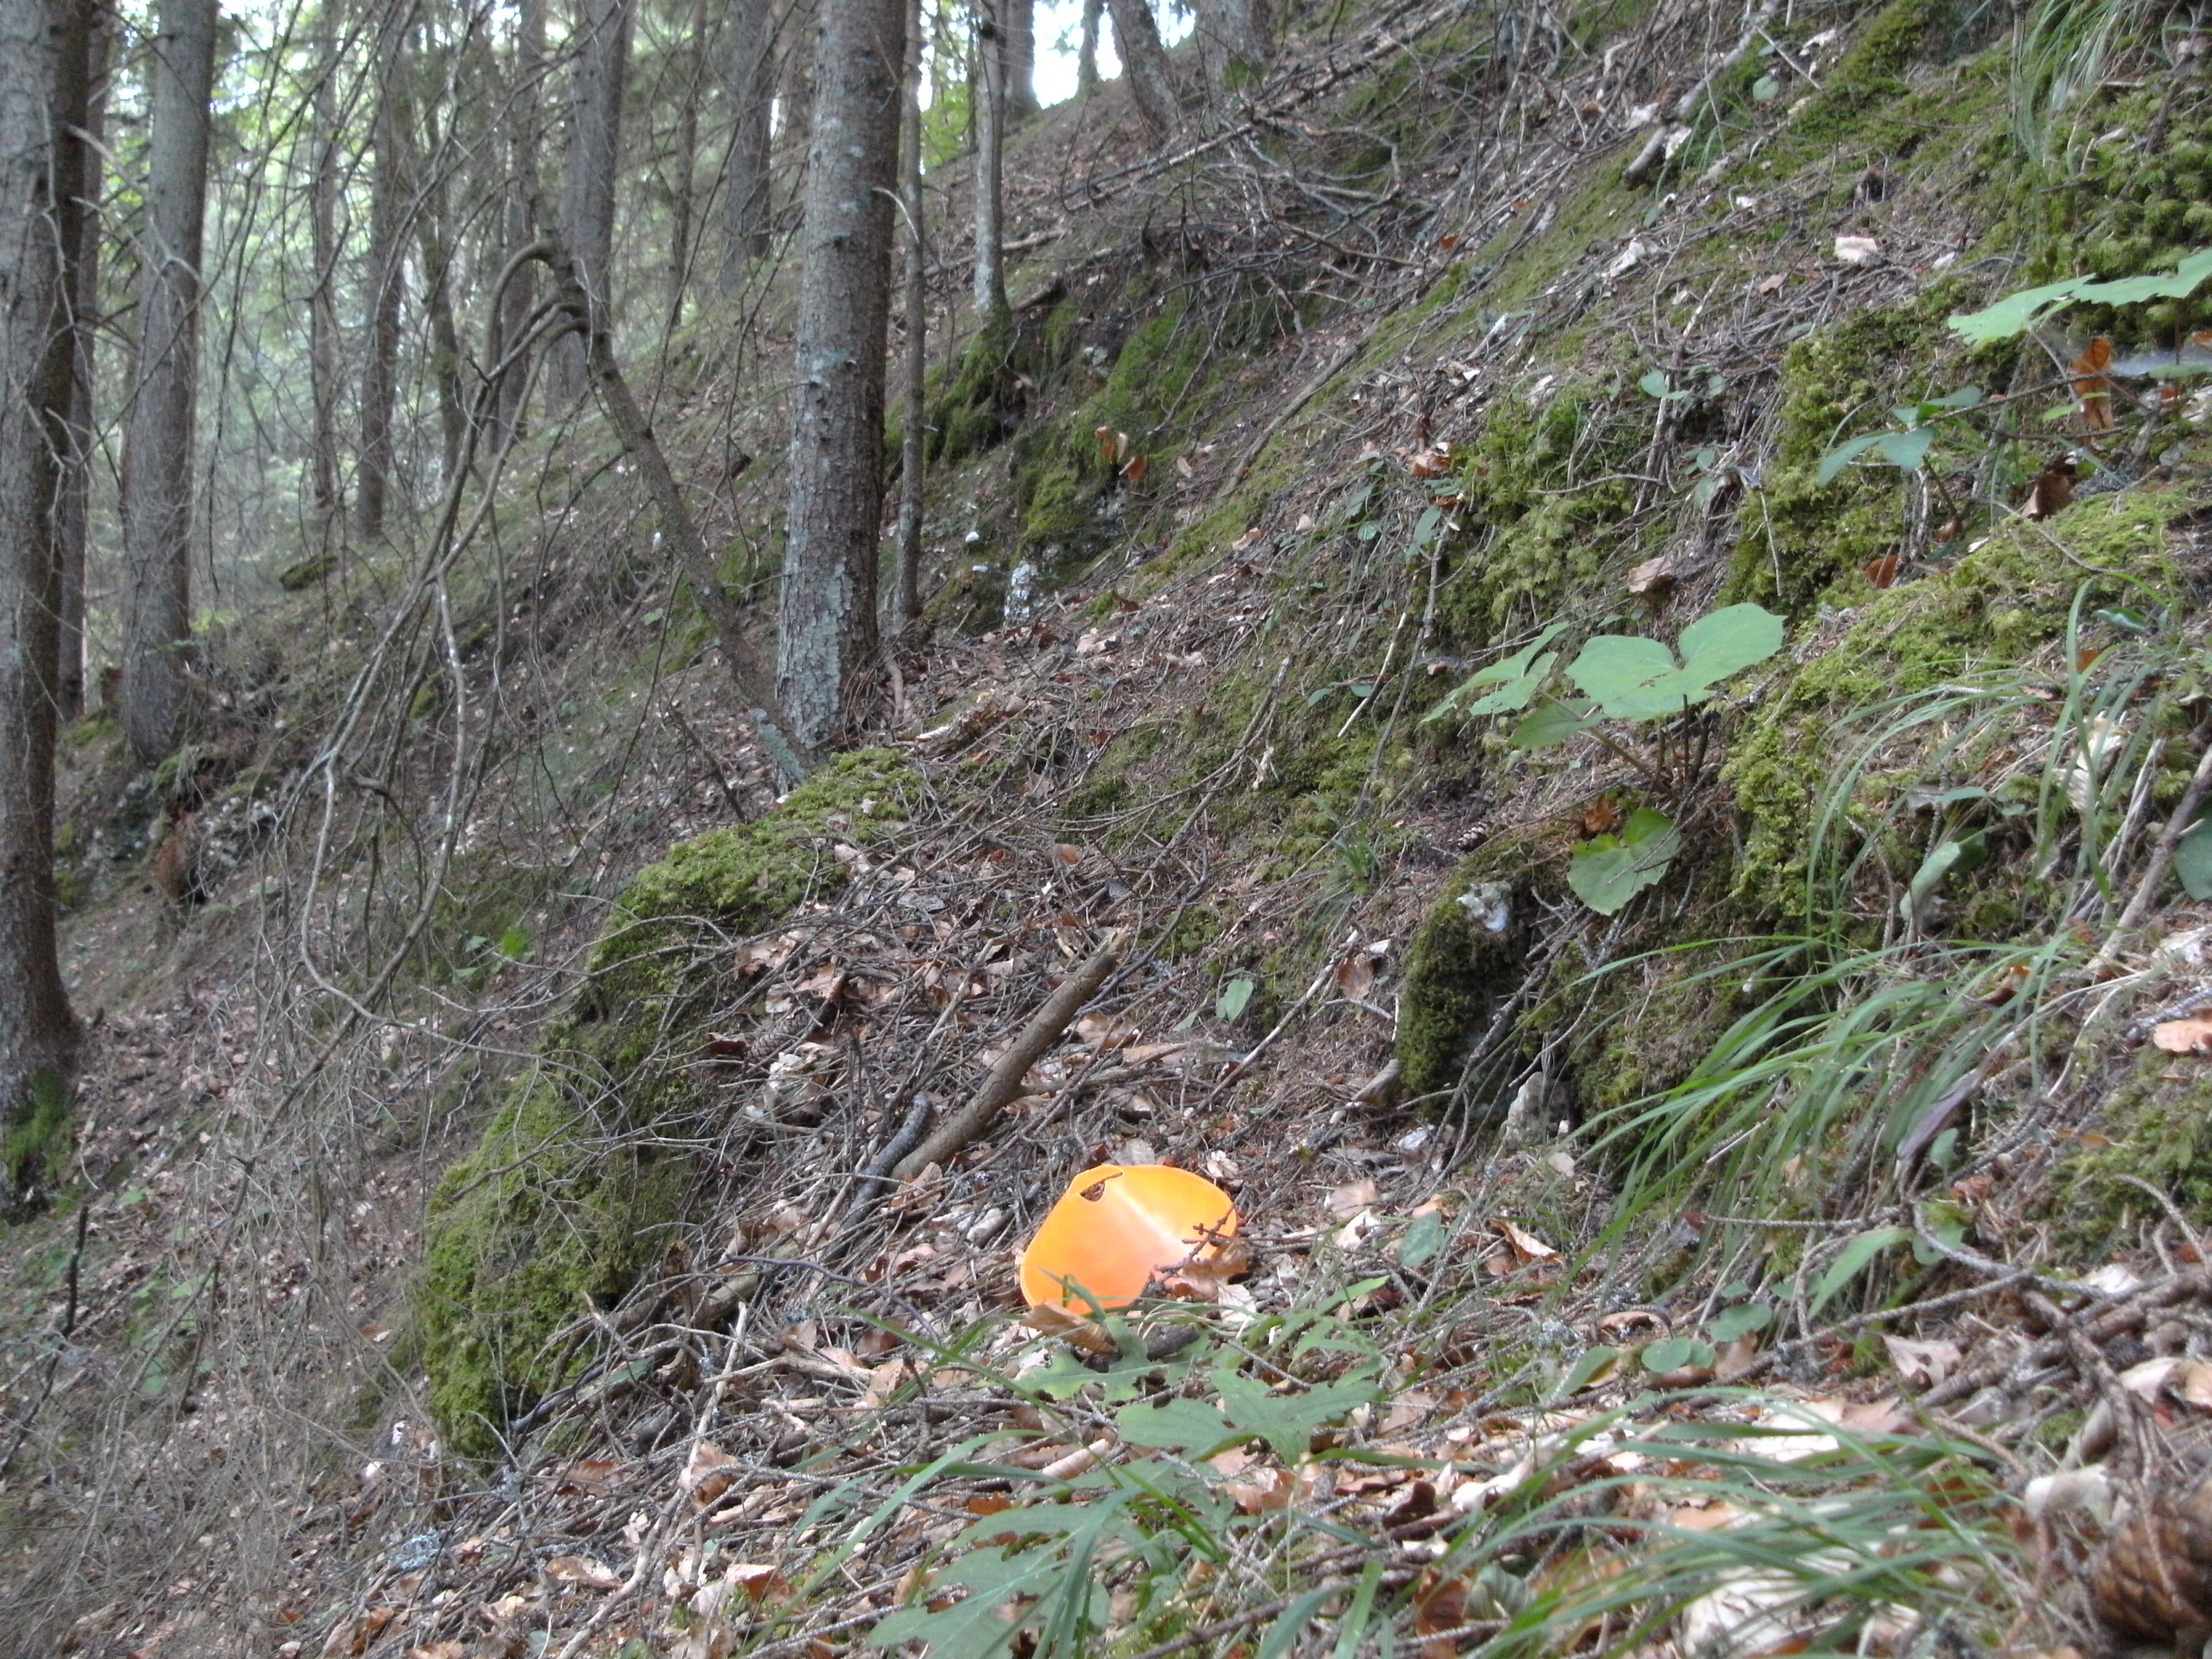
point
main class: Woodland
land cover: Spruce dominated coniferous woodland
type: hemiboreal forest and nemoral coniferous forest and mixed broadleaved-coniferous forest
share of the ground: > 75 %
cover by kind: coniferous forest trees 65 %, broadleaved forest trees 20 %, unconsolidated bare surface 10 %, lichens and mosses 5 %
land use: Forestry
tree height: > 5 m
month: July
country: AT
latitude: 46.5375
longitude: 14.6787
